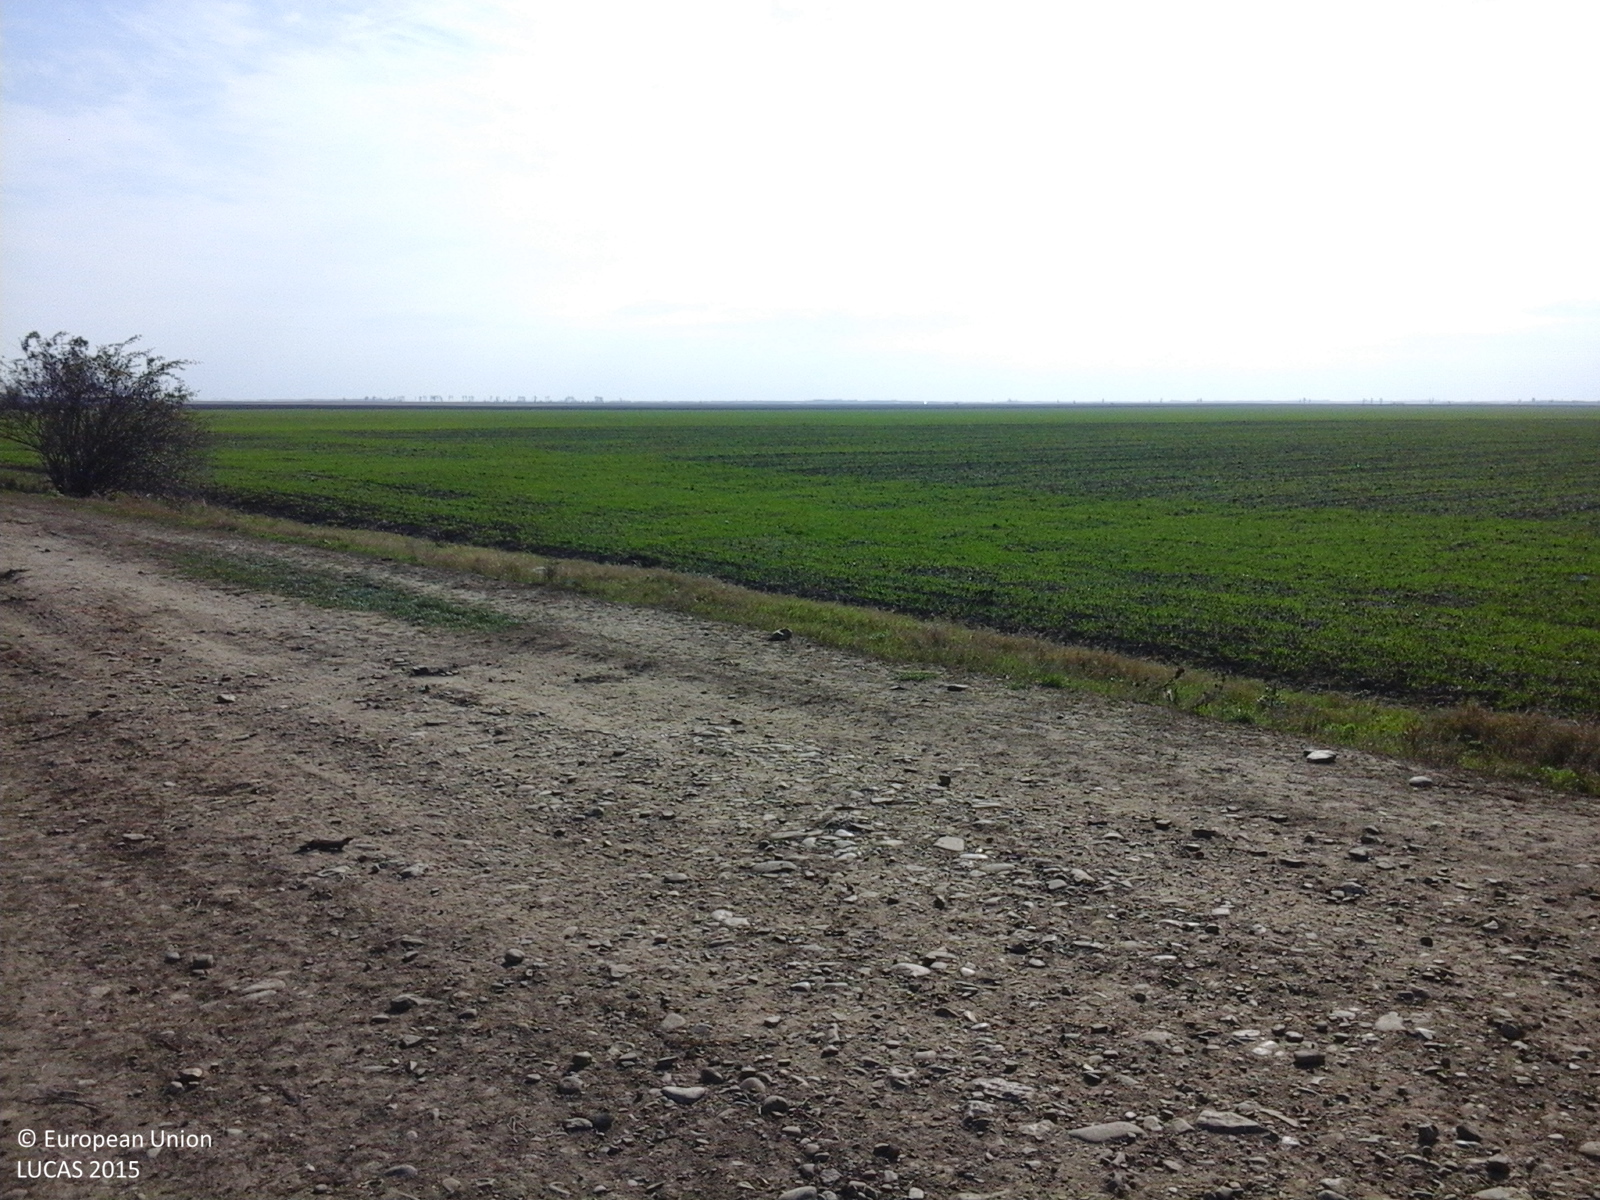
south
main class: Grassland
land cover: Spontaneously vegetated surfaces
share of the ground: > 75 %
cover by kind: herbaceous plants 100 %
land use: Fallow land
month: October
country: RO
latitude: 45.2306
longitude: 27.2494
